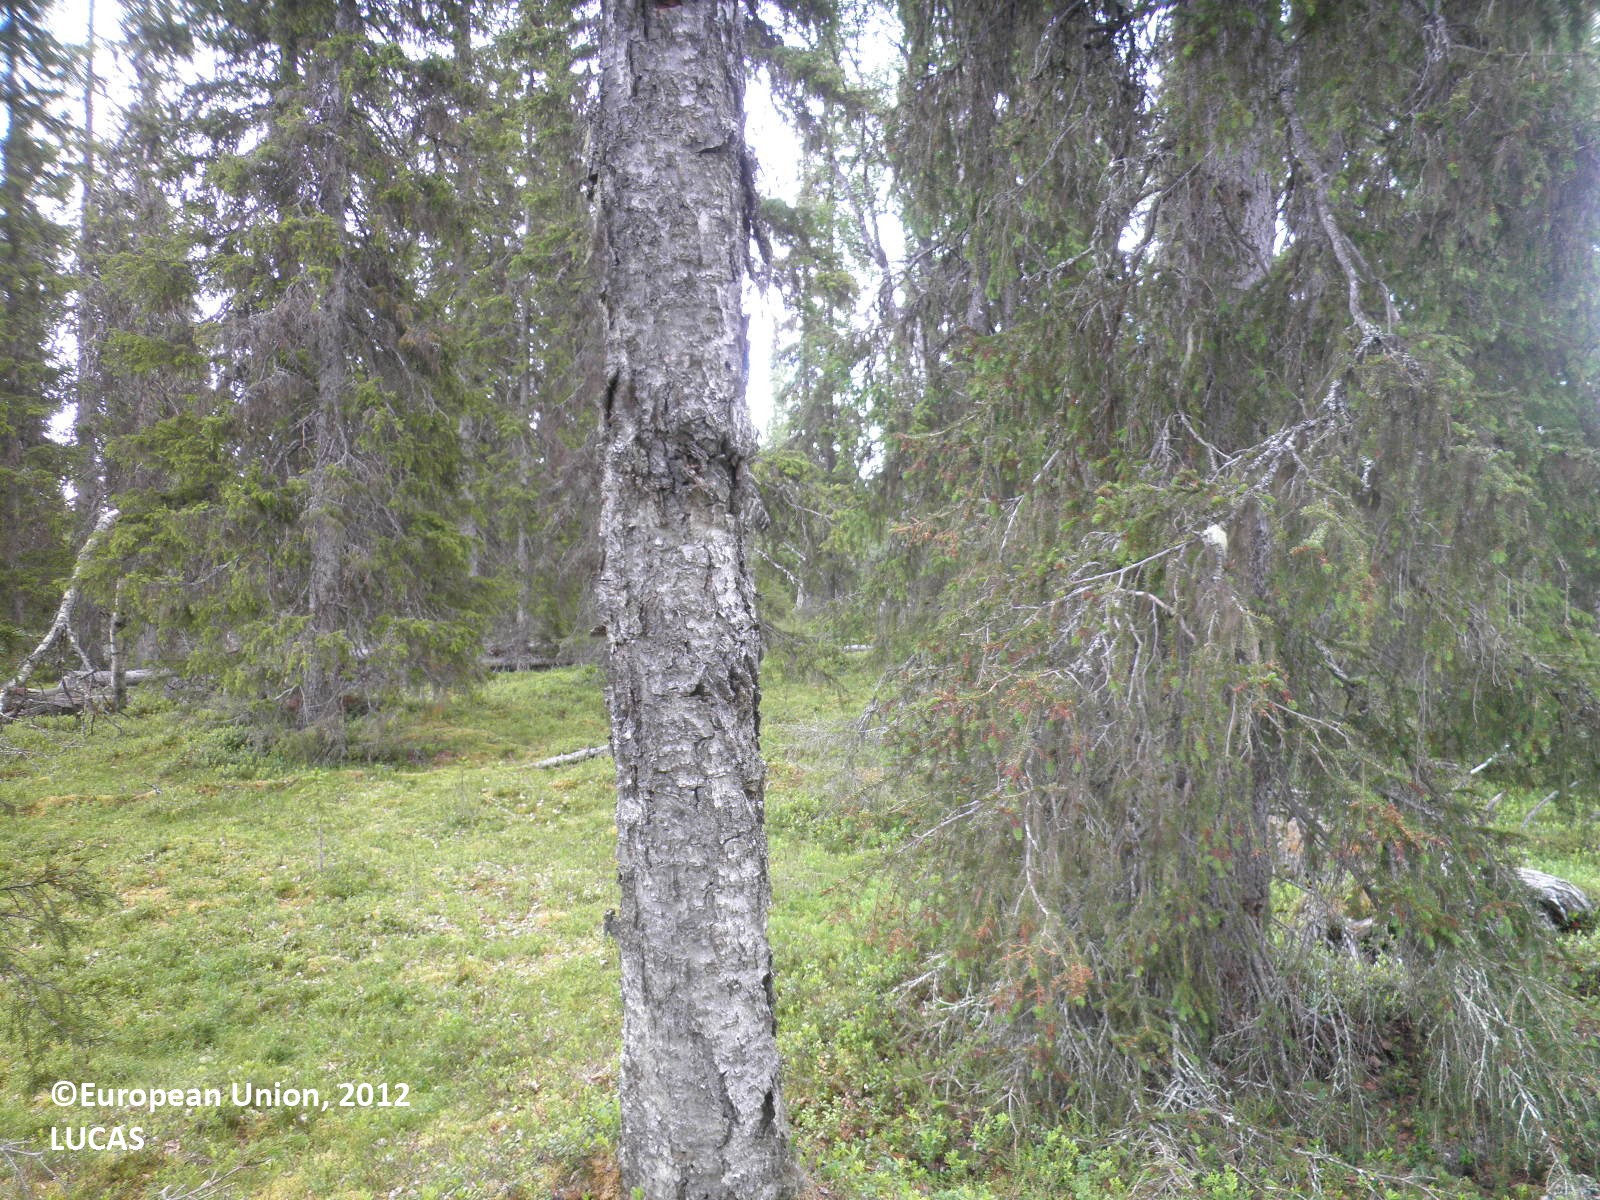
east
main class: Woodland
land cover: Spruce dominated mixed woodland
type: boreal forest
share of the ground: 50 - 75 %
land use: Forestry
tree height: > 5 m
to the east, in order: Spruce dominated mixed woodland; Ponds and wetlands; Spruce dominated mixed woodland; Inland marshes; Spruce dominated mixed woodland
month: July
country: FI
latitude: 67.9613
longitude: 26.1758
